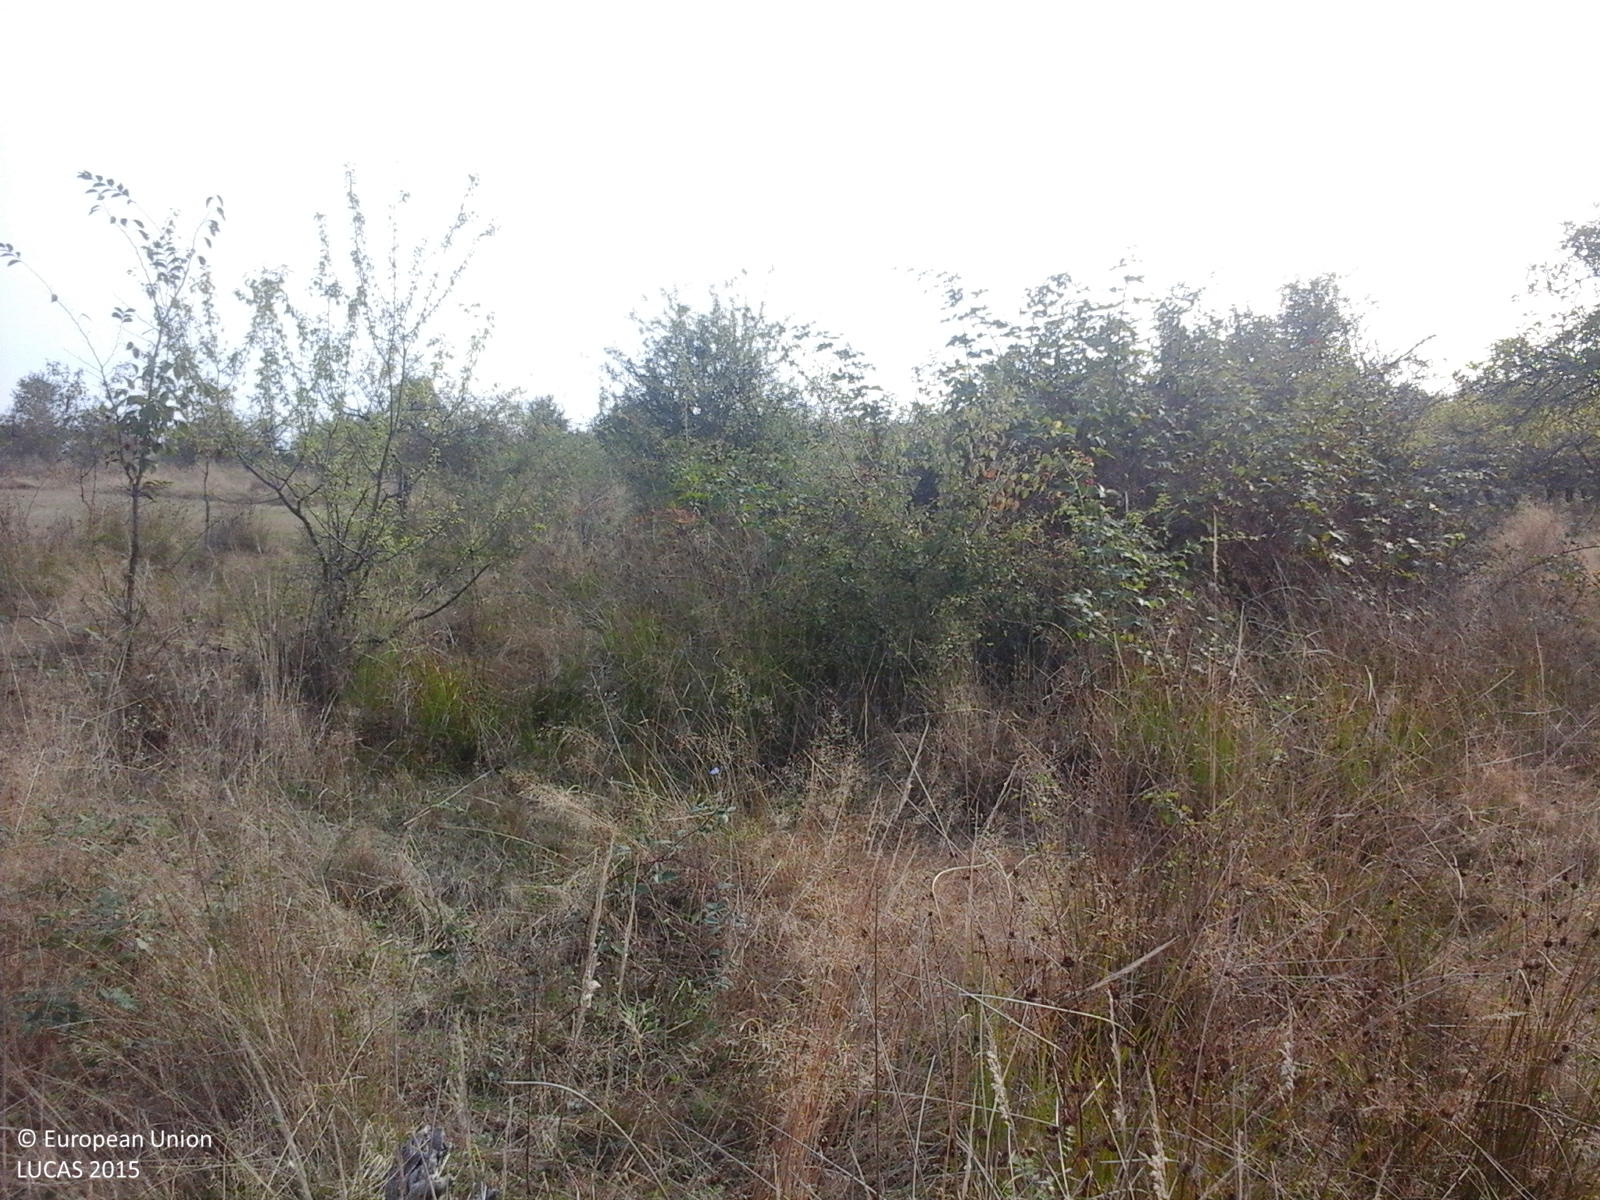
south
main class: Cropland
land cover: Other fruit trees and berries
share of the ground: 50 - 75 %
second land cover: Spontaneously vegetated surfaces
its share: > 75 %
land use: Agriculture (excluding fallow land and kitchen gardens)
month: September
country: RO
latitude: 45.4018
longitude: 21.9827
